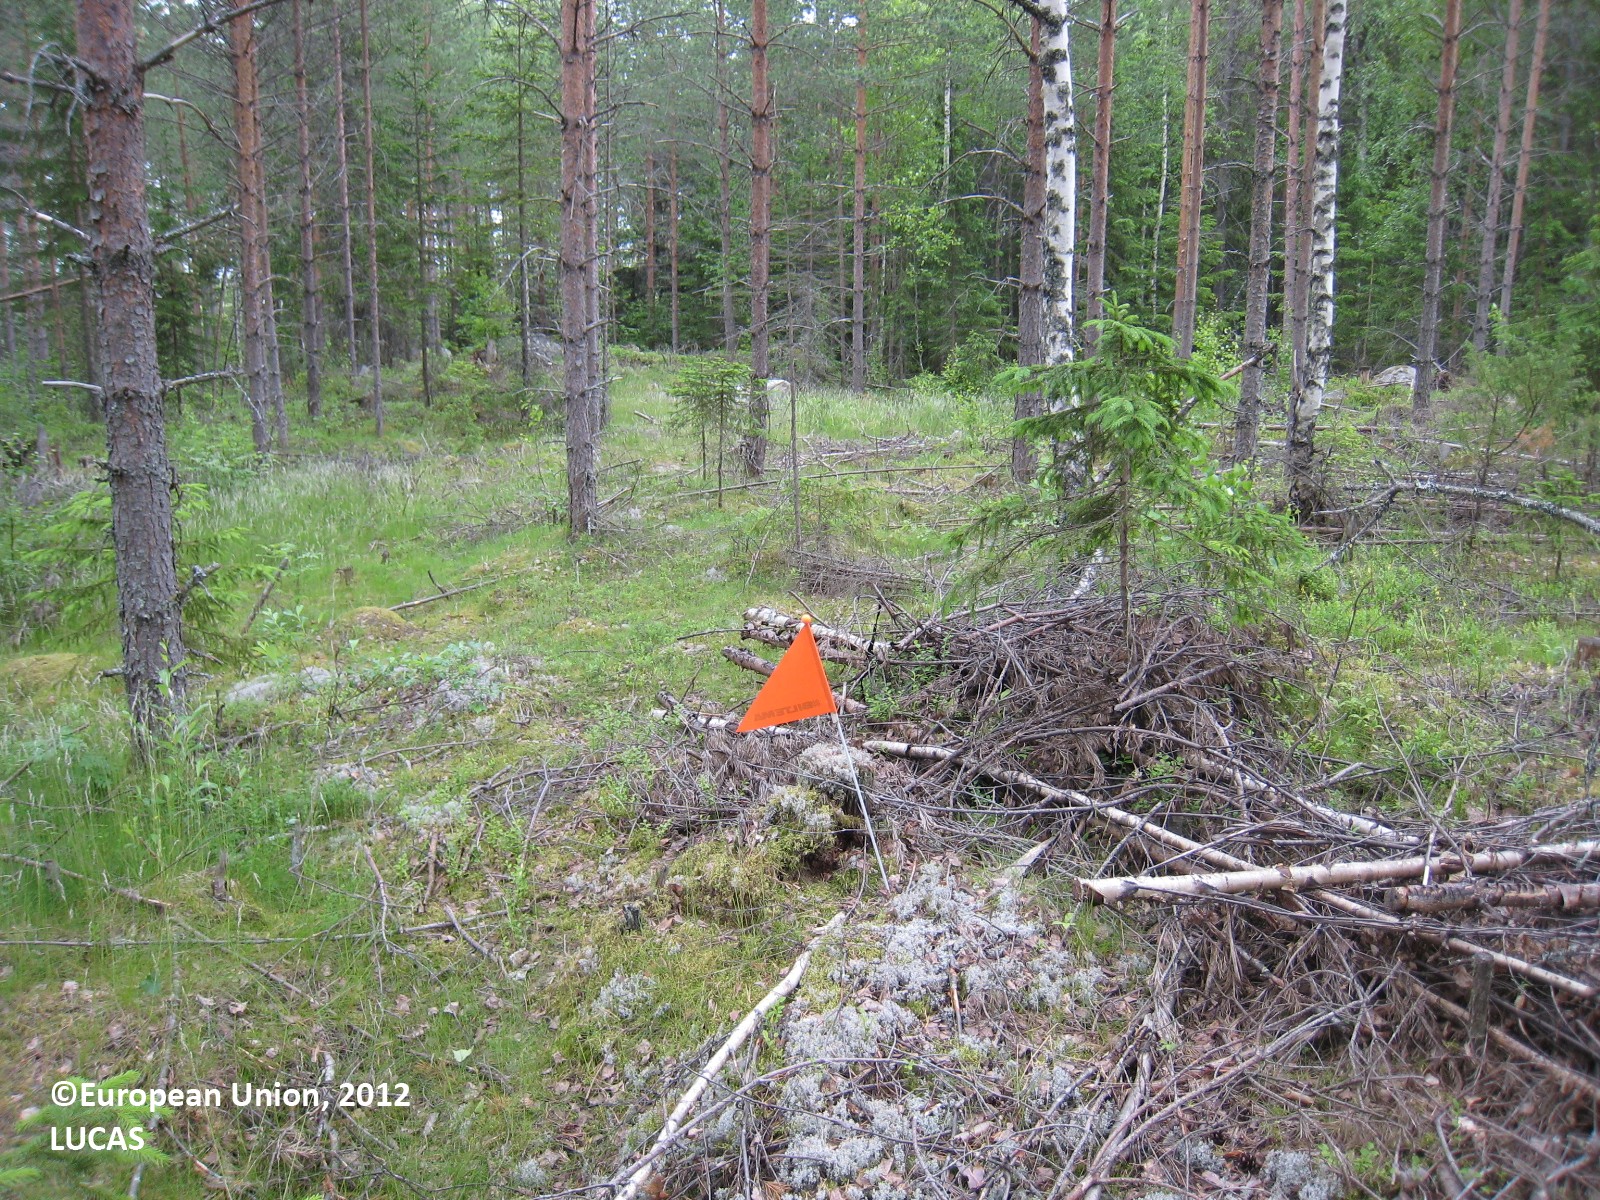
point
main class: Woodland
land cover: Pine dominated coniferous woodland
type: boreal forest
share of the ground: 50 - 75 %
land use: Forestry
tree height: > 5 m
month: June
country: FI
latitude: 62.1700
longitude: 26.3618
